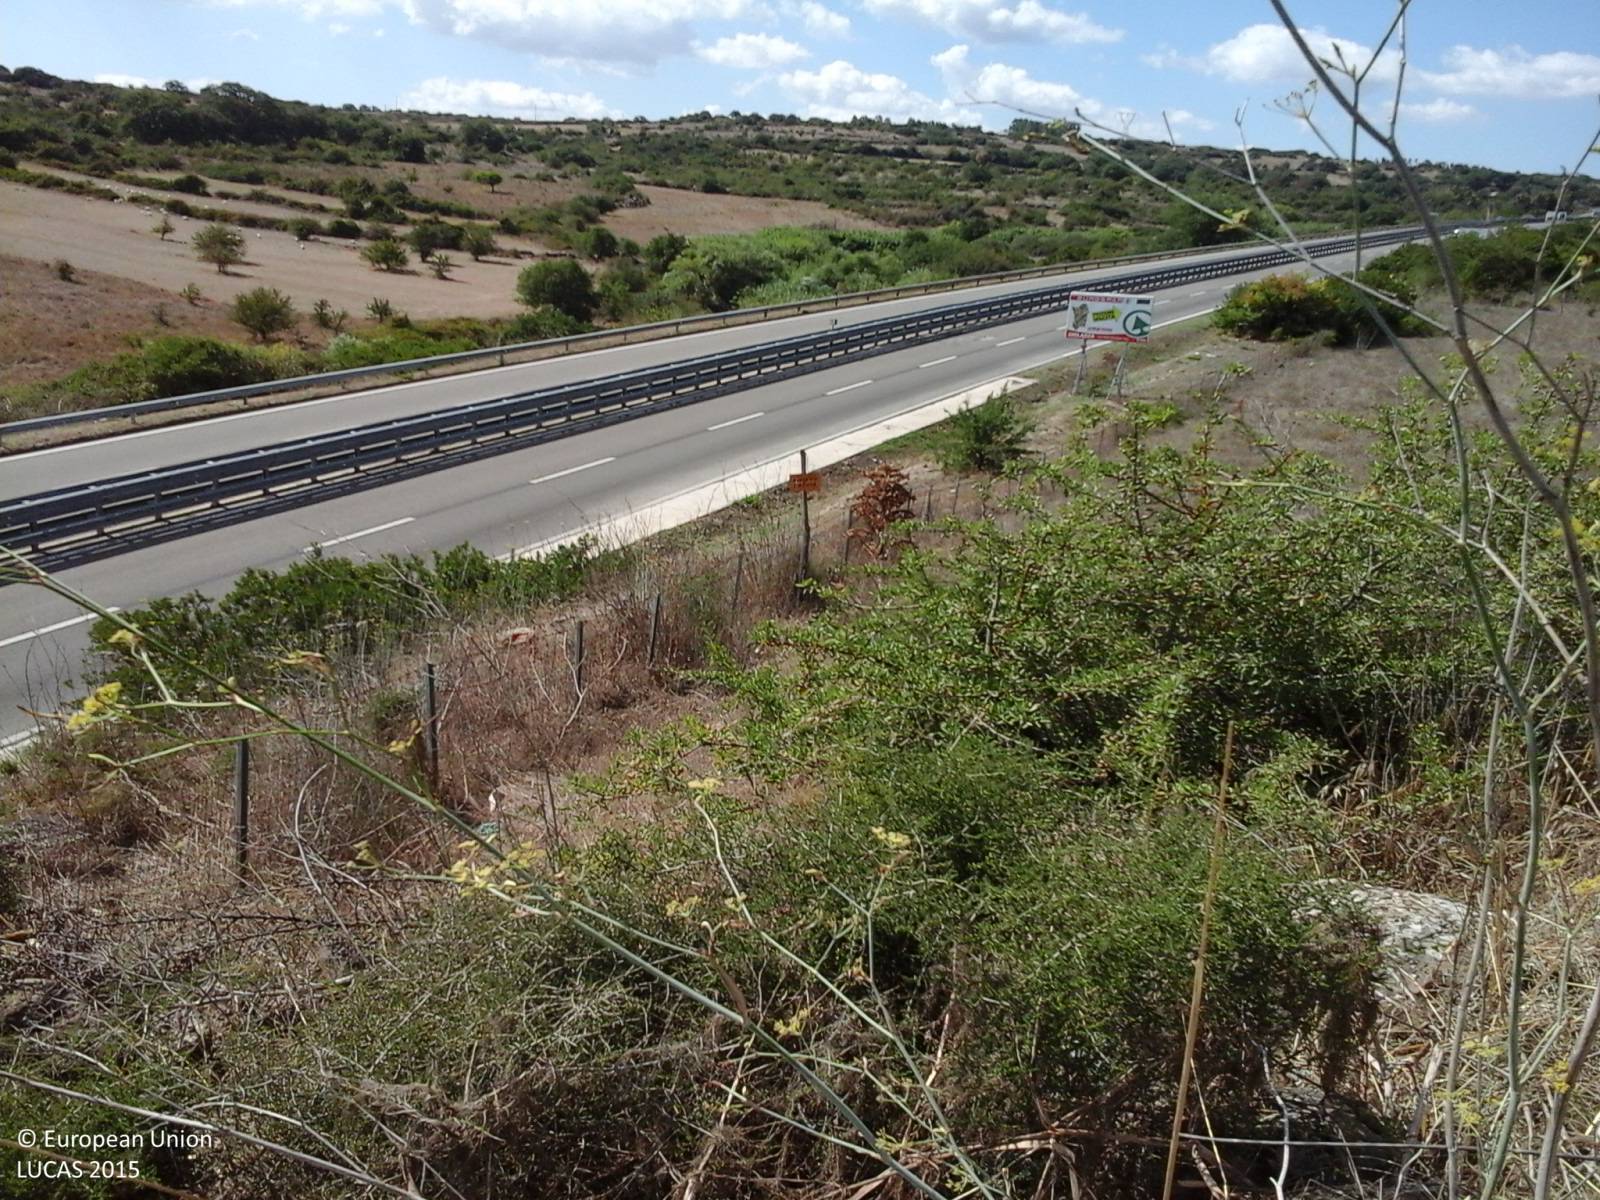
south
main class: Grassland
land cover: Grassland without tree/shrub cover
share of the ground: > 75 %
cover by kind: herbaceous plants 100 %
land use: Agriculture (excluding fallow land and kitchen gardens)
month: August
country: IT
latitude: 40.1341
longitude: 8.8676
